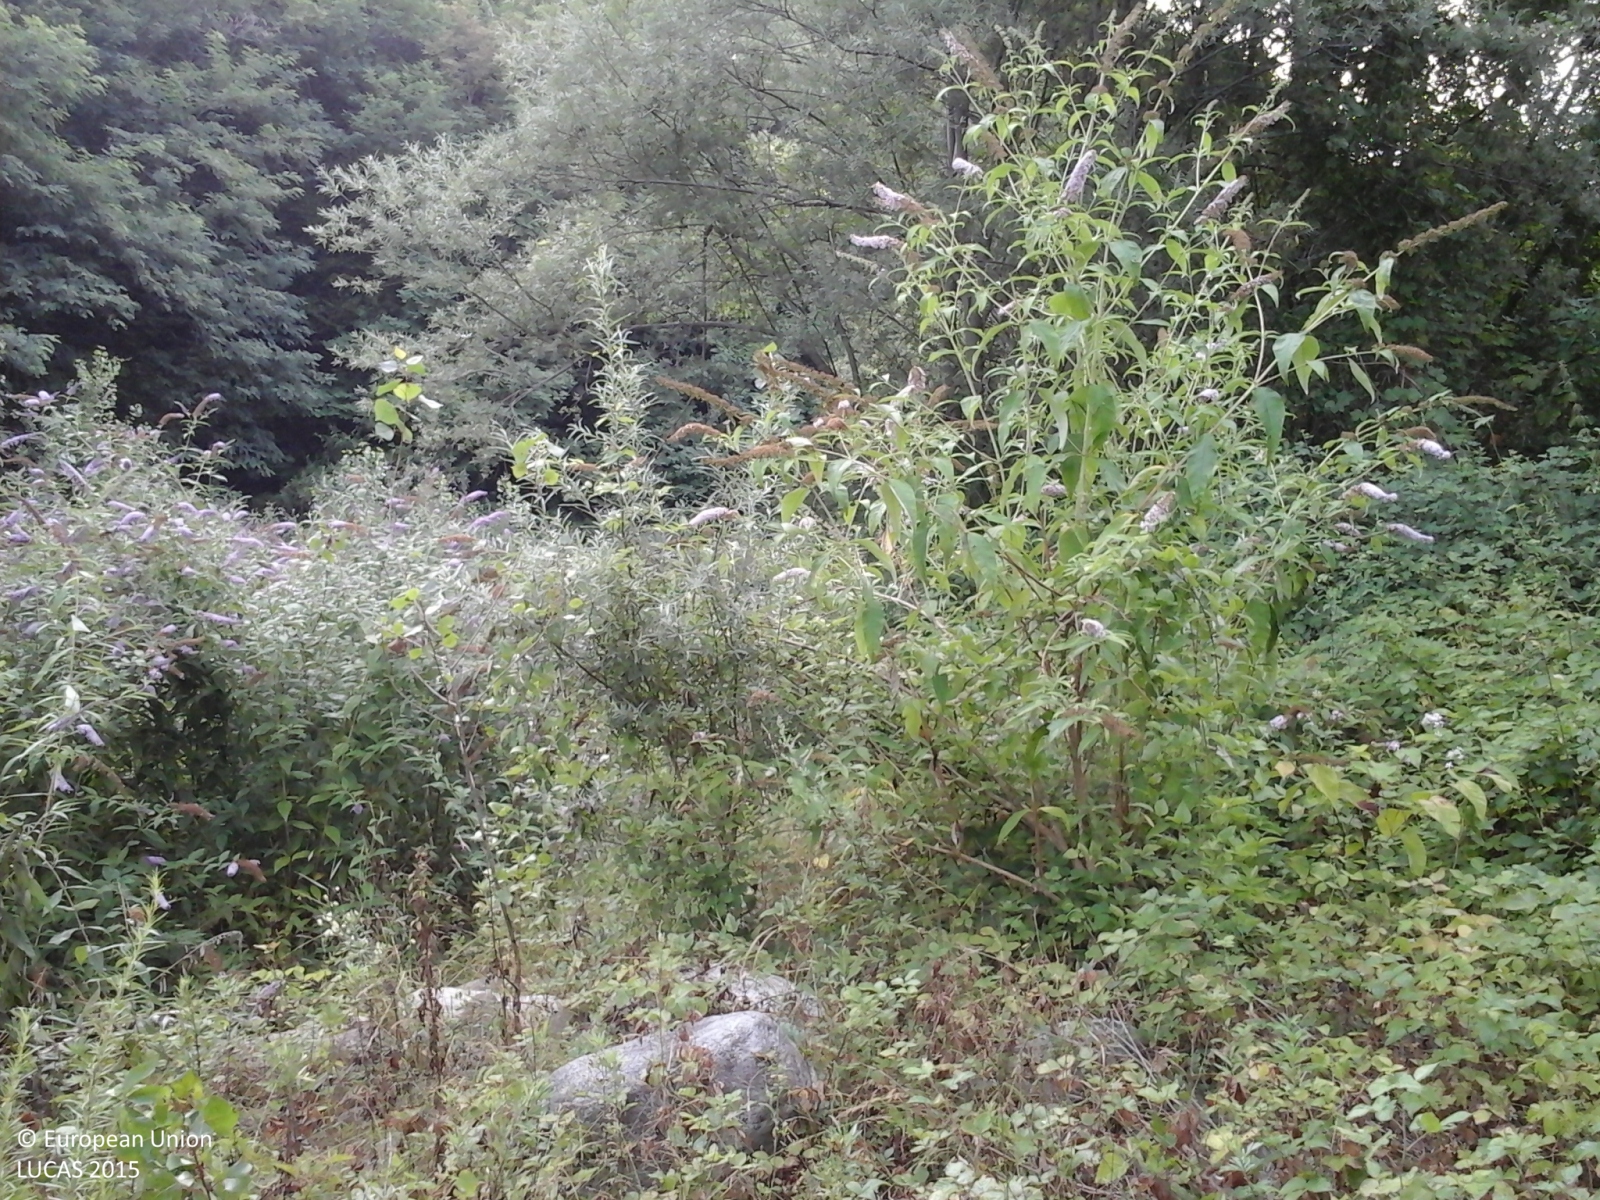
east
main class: Woodland
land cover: Broadleaved woodland
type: thermophilous deciduous forest
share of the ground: > 75 %
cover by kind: broadleaved forest trees 80 %, shrubs 20 %
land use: Semi-natural and natural areas not in use
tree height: > 5 m
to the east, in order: Broadleaved woodland; Inland fresh running water; Broadleaved woodland; Grassland without tree/shrub cover; Electric lines; Broadleaved woodland; Grassland without tree/shrub cover; Electric lines; Grassland without tree/shrub cover; Broadleaved woodland; Dry stone walls; Broadleaved woodland
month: July
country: IT
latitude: 44.6588
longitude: 7.3189
